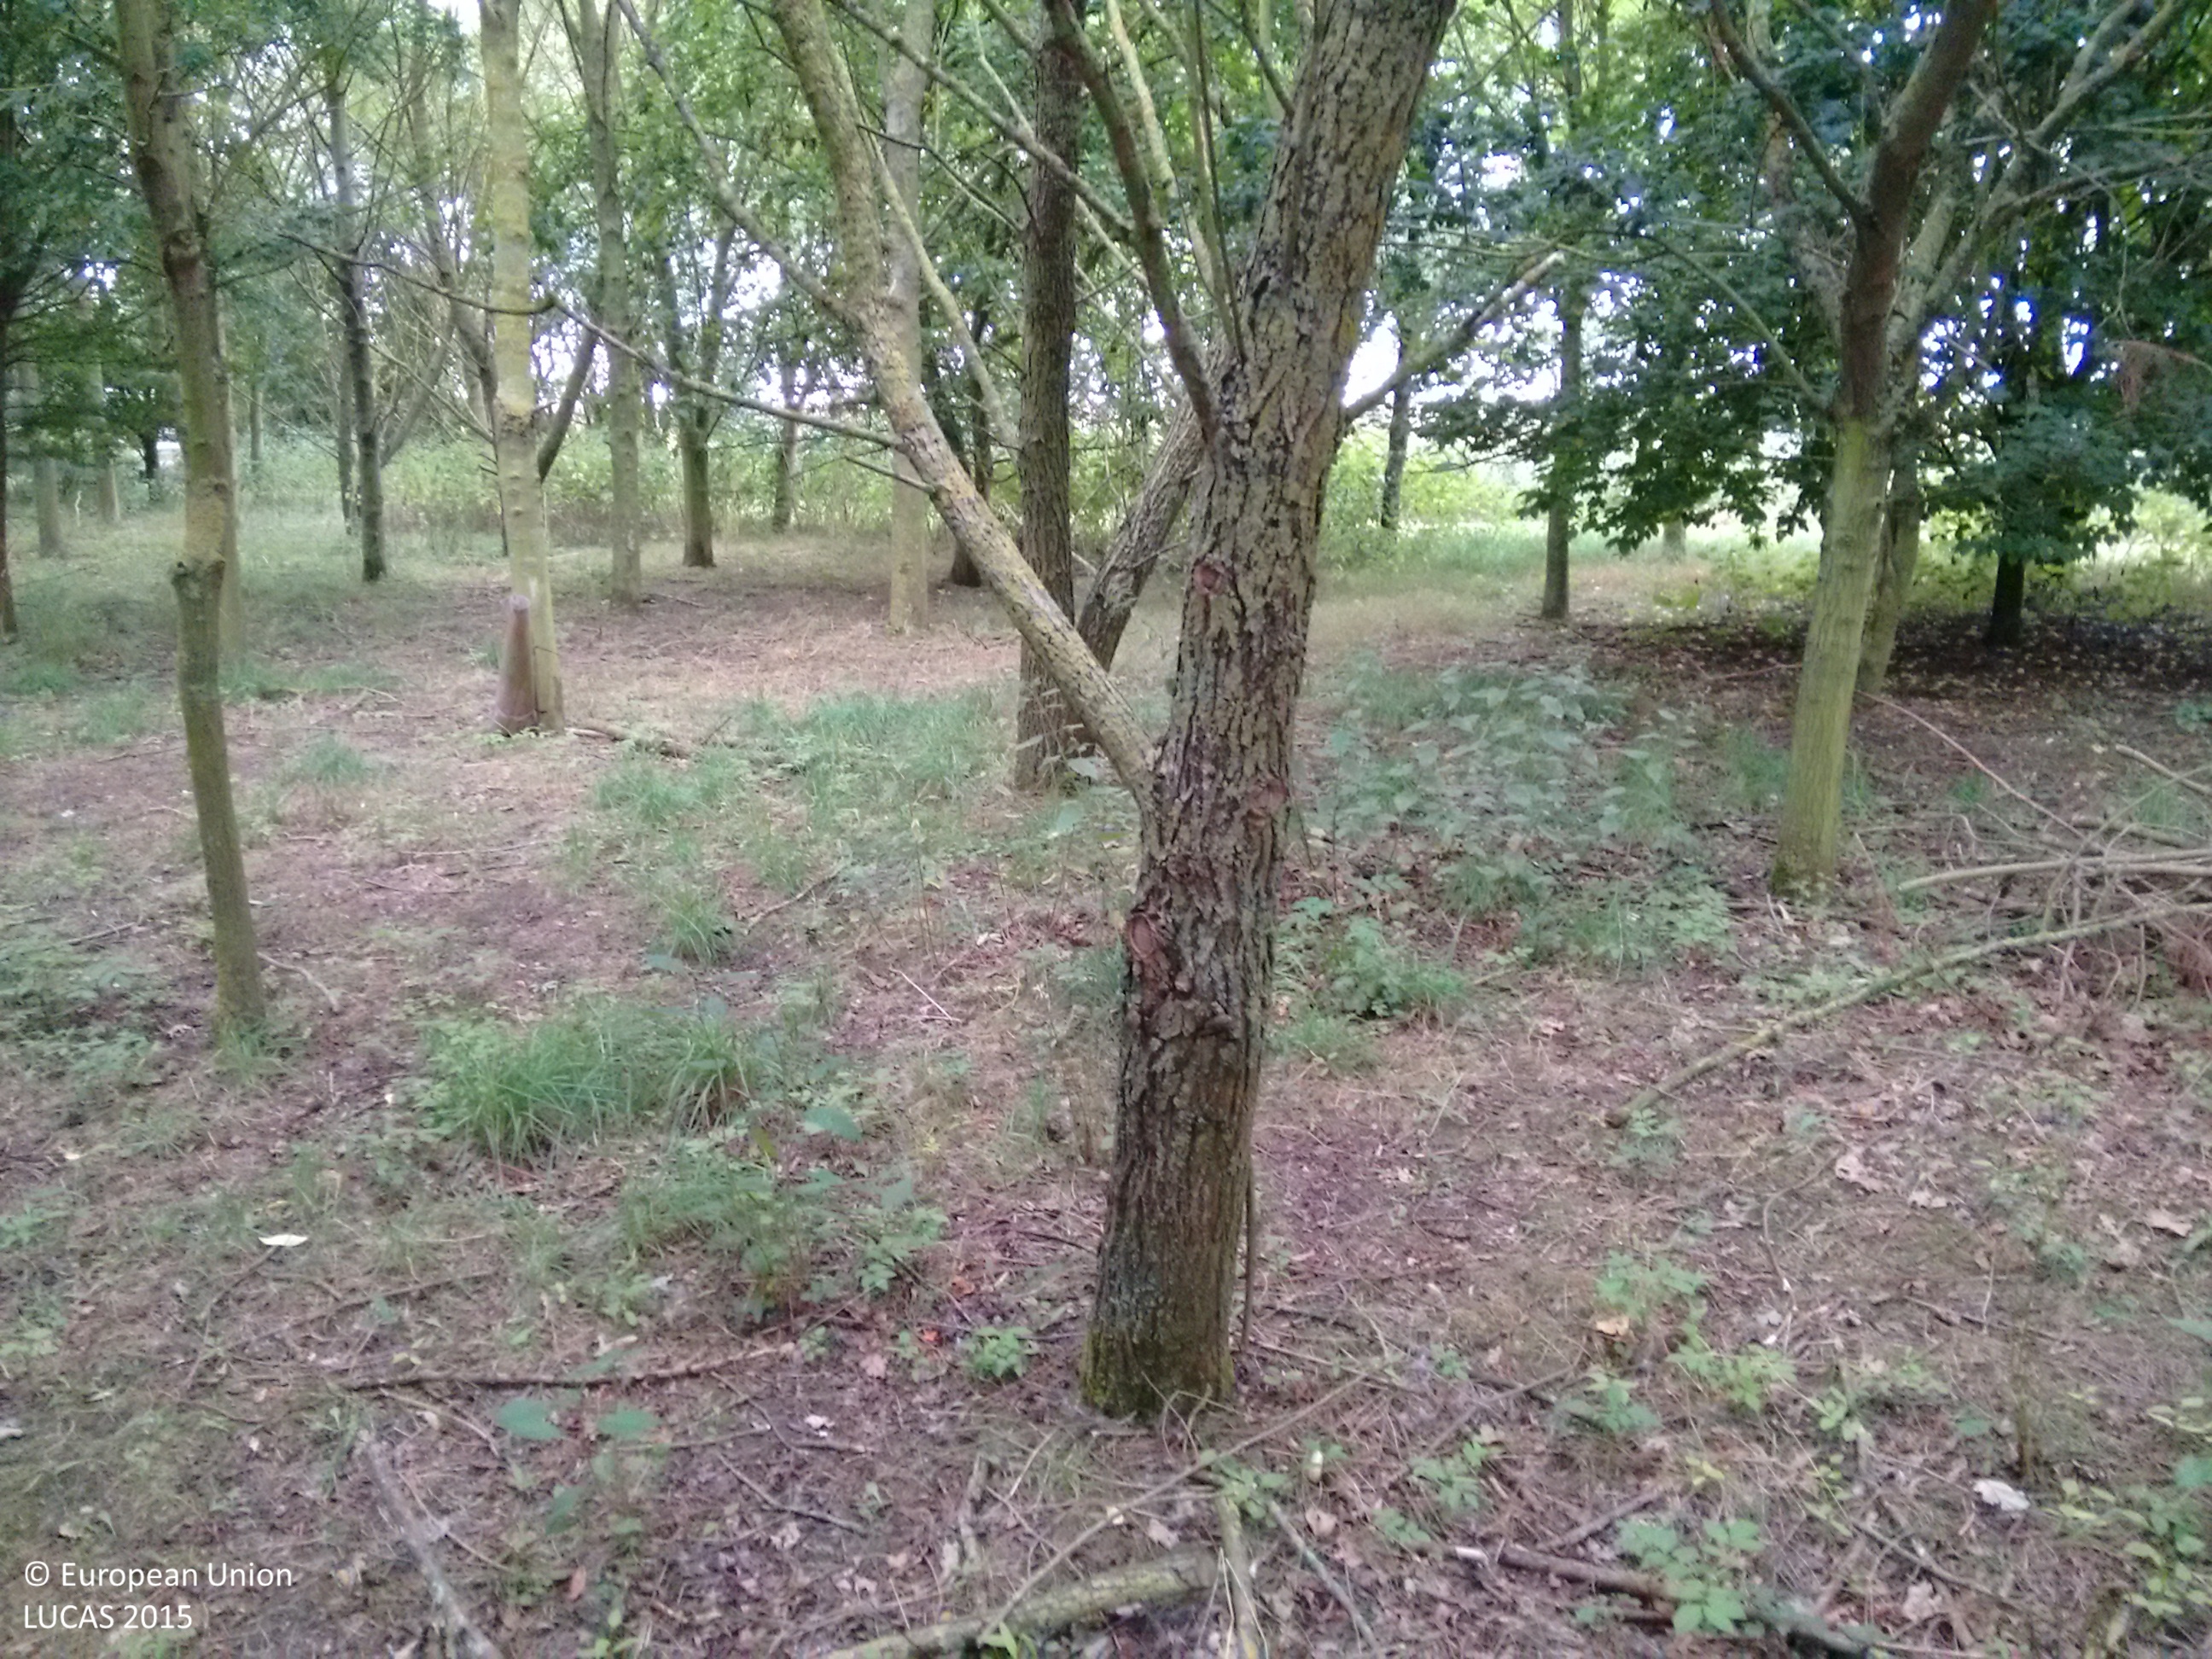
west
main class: Woodland
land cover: Other mixed woodland
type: exotic forest
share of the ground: > 75 %
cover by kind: broadleaved forest trees 60 %, coniferous forest trees 40 %
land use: Sport
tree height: > 5 m
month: August
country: GB
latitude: 52.3794
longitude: 0.3190
